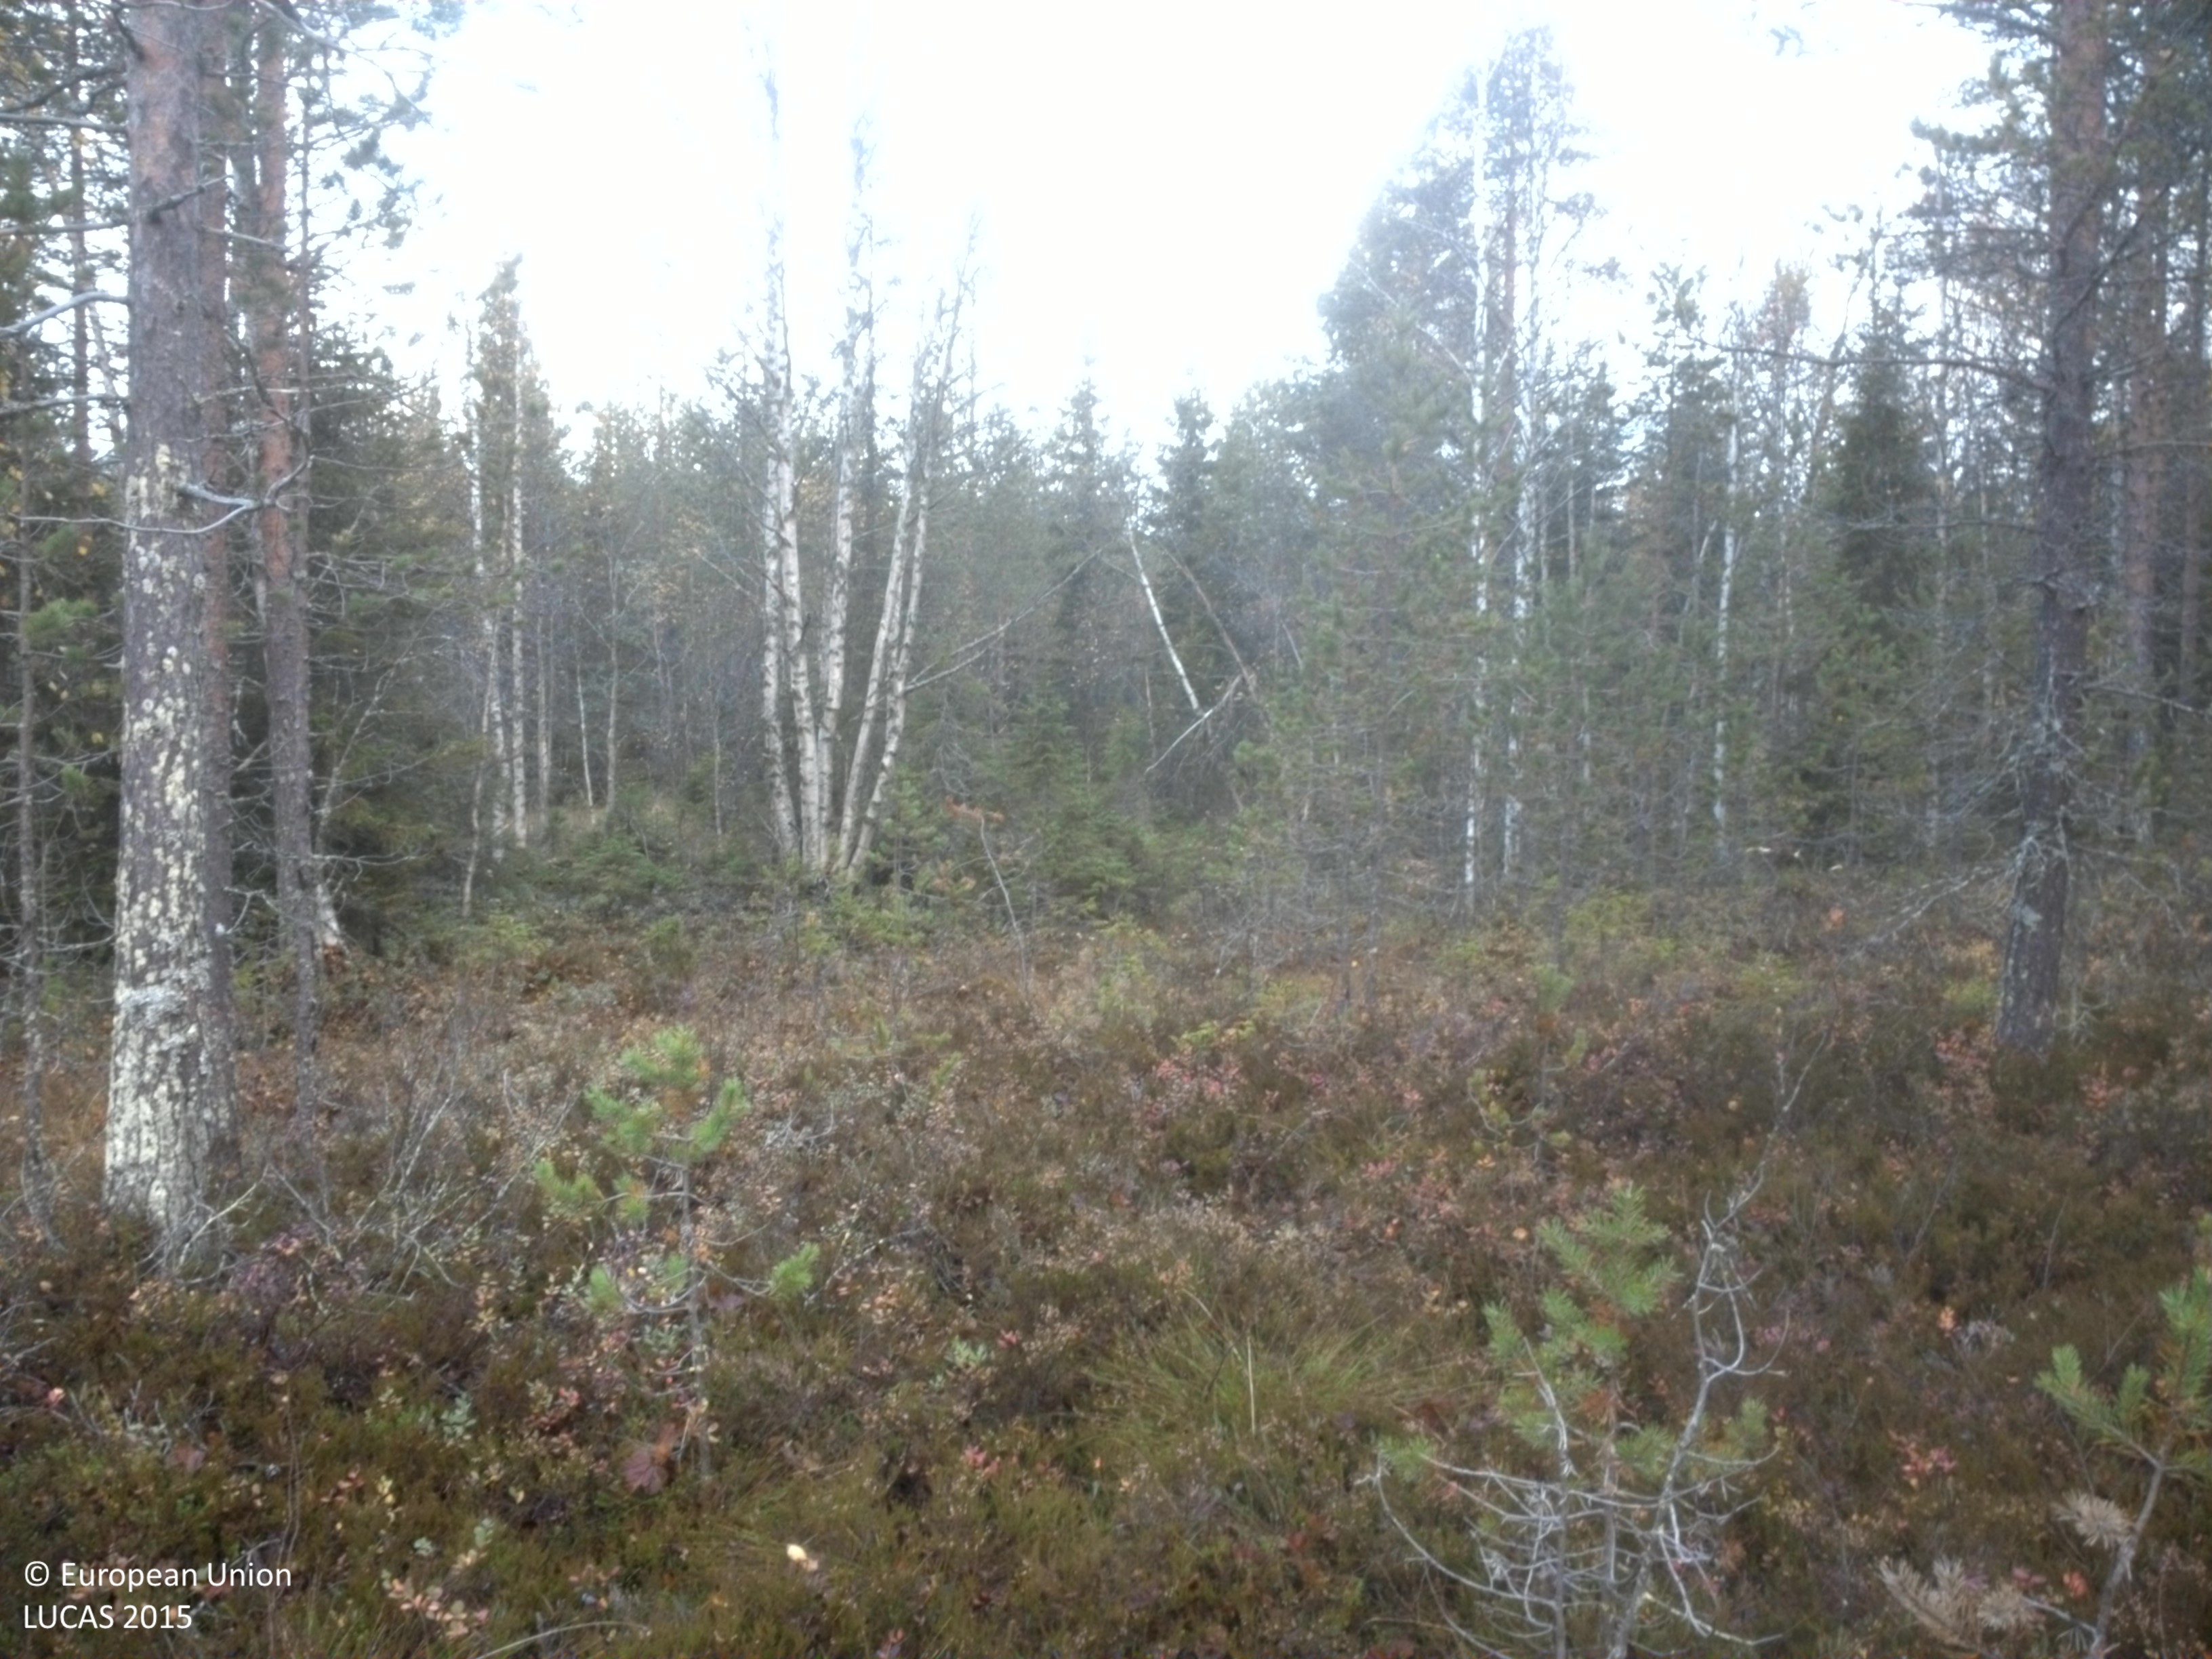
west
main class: Woodland
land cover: Pine dominated coniferous woodland
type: boreal forest
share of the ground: 25 - 50 %
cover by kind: coniferous forest trees 40 %, shrubs 30 %, lichens and mosses 25 %, herbaceous plants 5 %
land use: Semi-natural and natural areas not in use
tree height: > 5 m
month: September
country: SE
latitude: 64.2141
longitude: 19.9278
